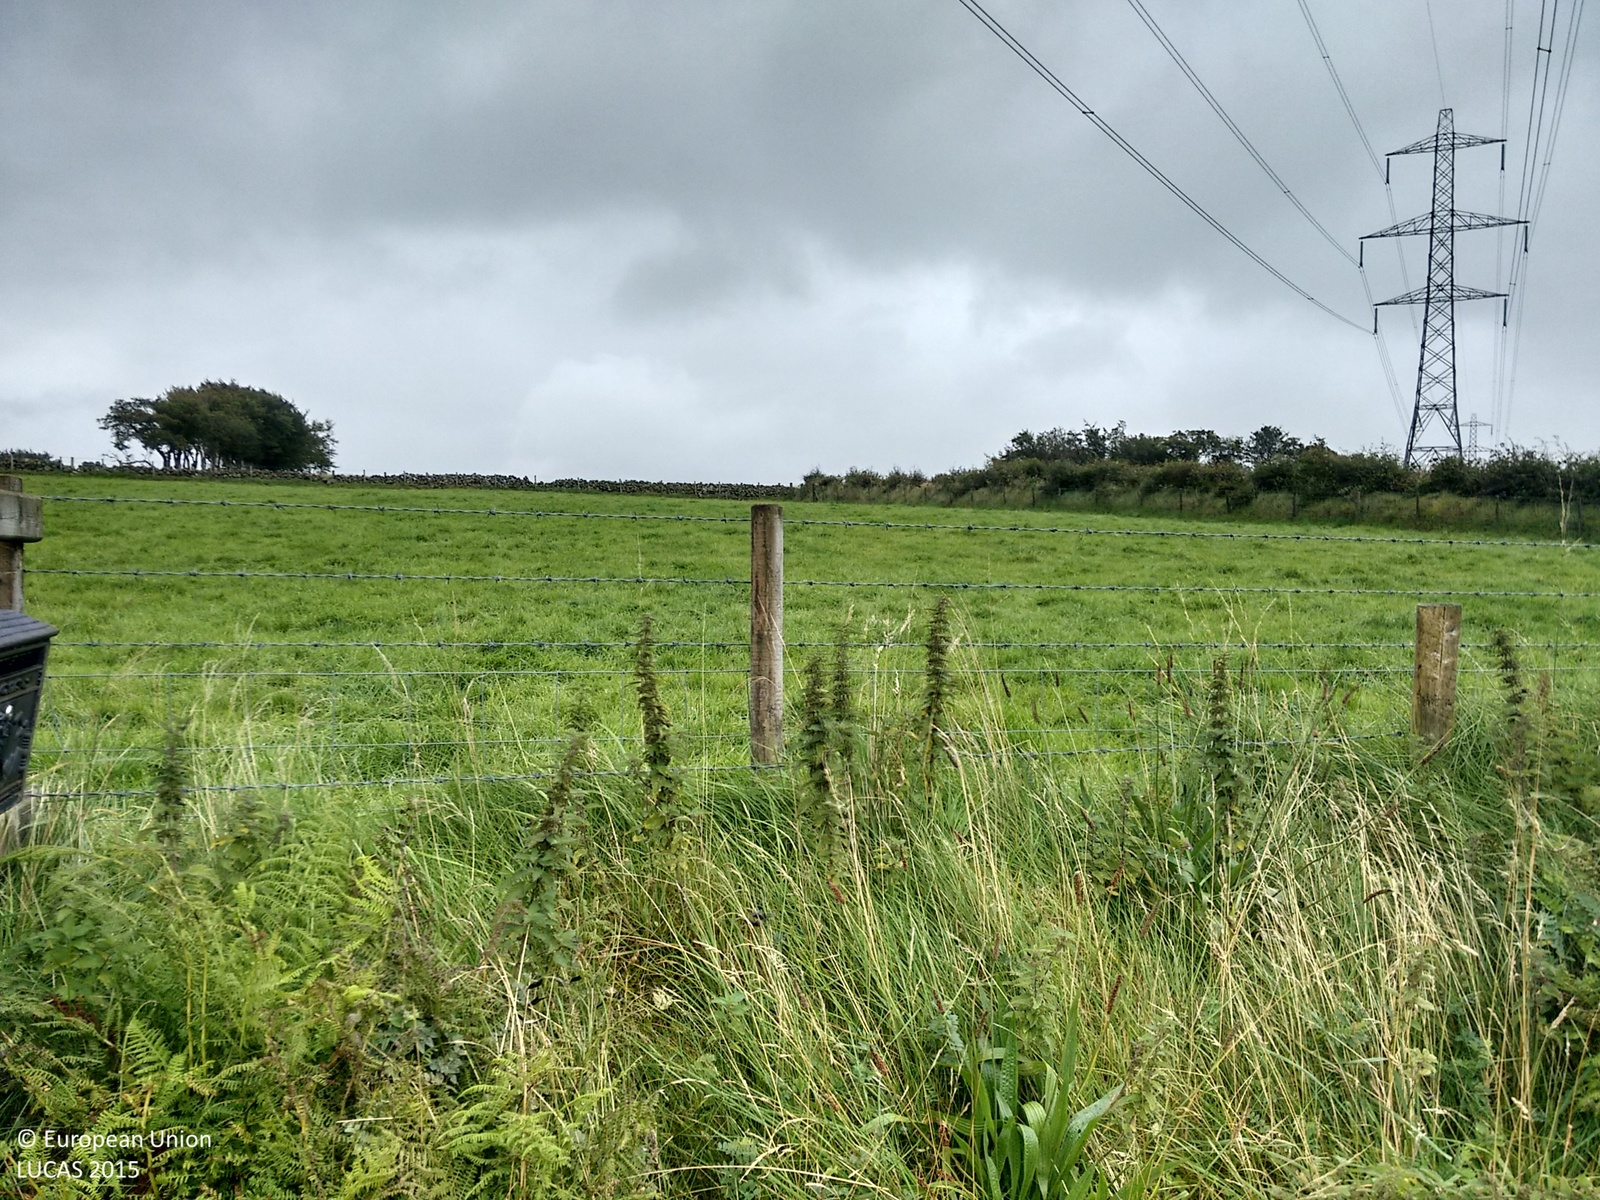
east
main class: Grassland
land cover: Grassland without tree/shrub cover
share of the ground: > 75 %
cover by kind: herbaceous plants 100 %
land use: Agriculture (excluding fallow land and kitchen gardens)
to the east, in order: Grassland without tree/shrub cover; Fences; Dry stone walls; Grassland without tree/shrub cover; Abandoned hedges; Dry stone walls; Grassland without tree/shrub cover; Fences; Dry stone walls; Grass margins; Paved roads, cycling and walking lanes; Grass margins; Fences; Dry stone walls; Grassland without tree/shrub cover; Dry stone walls; Grassland without tree/shrub cover
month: September
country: GB
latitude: 54.7707
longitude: -5.8514
